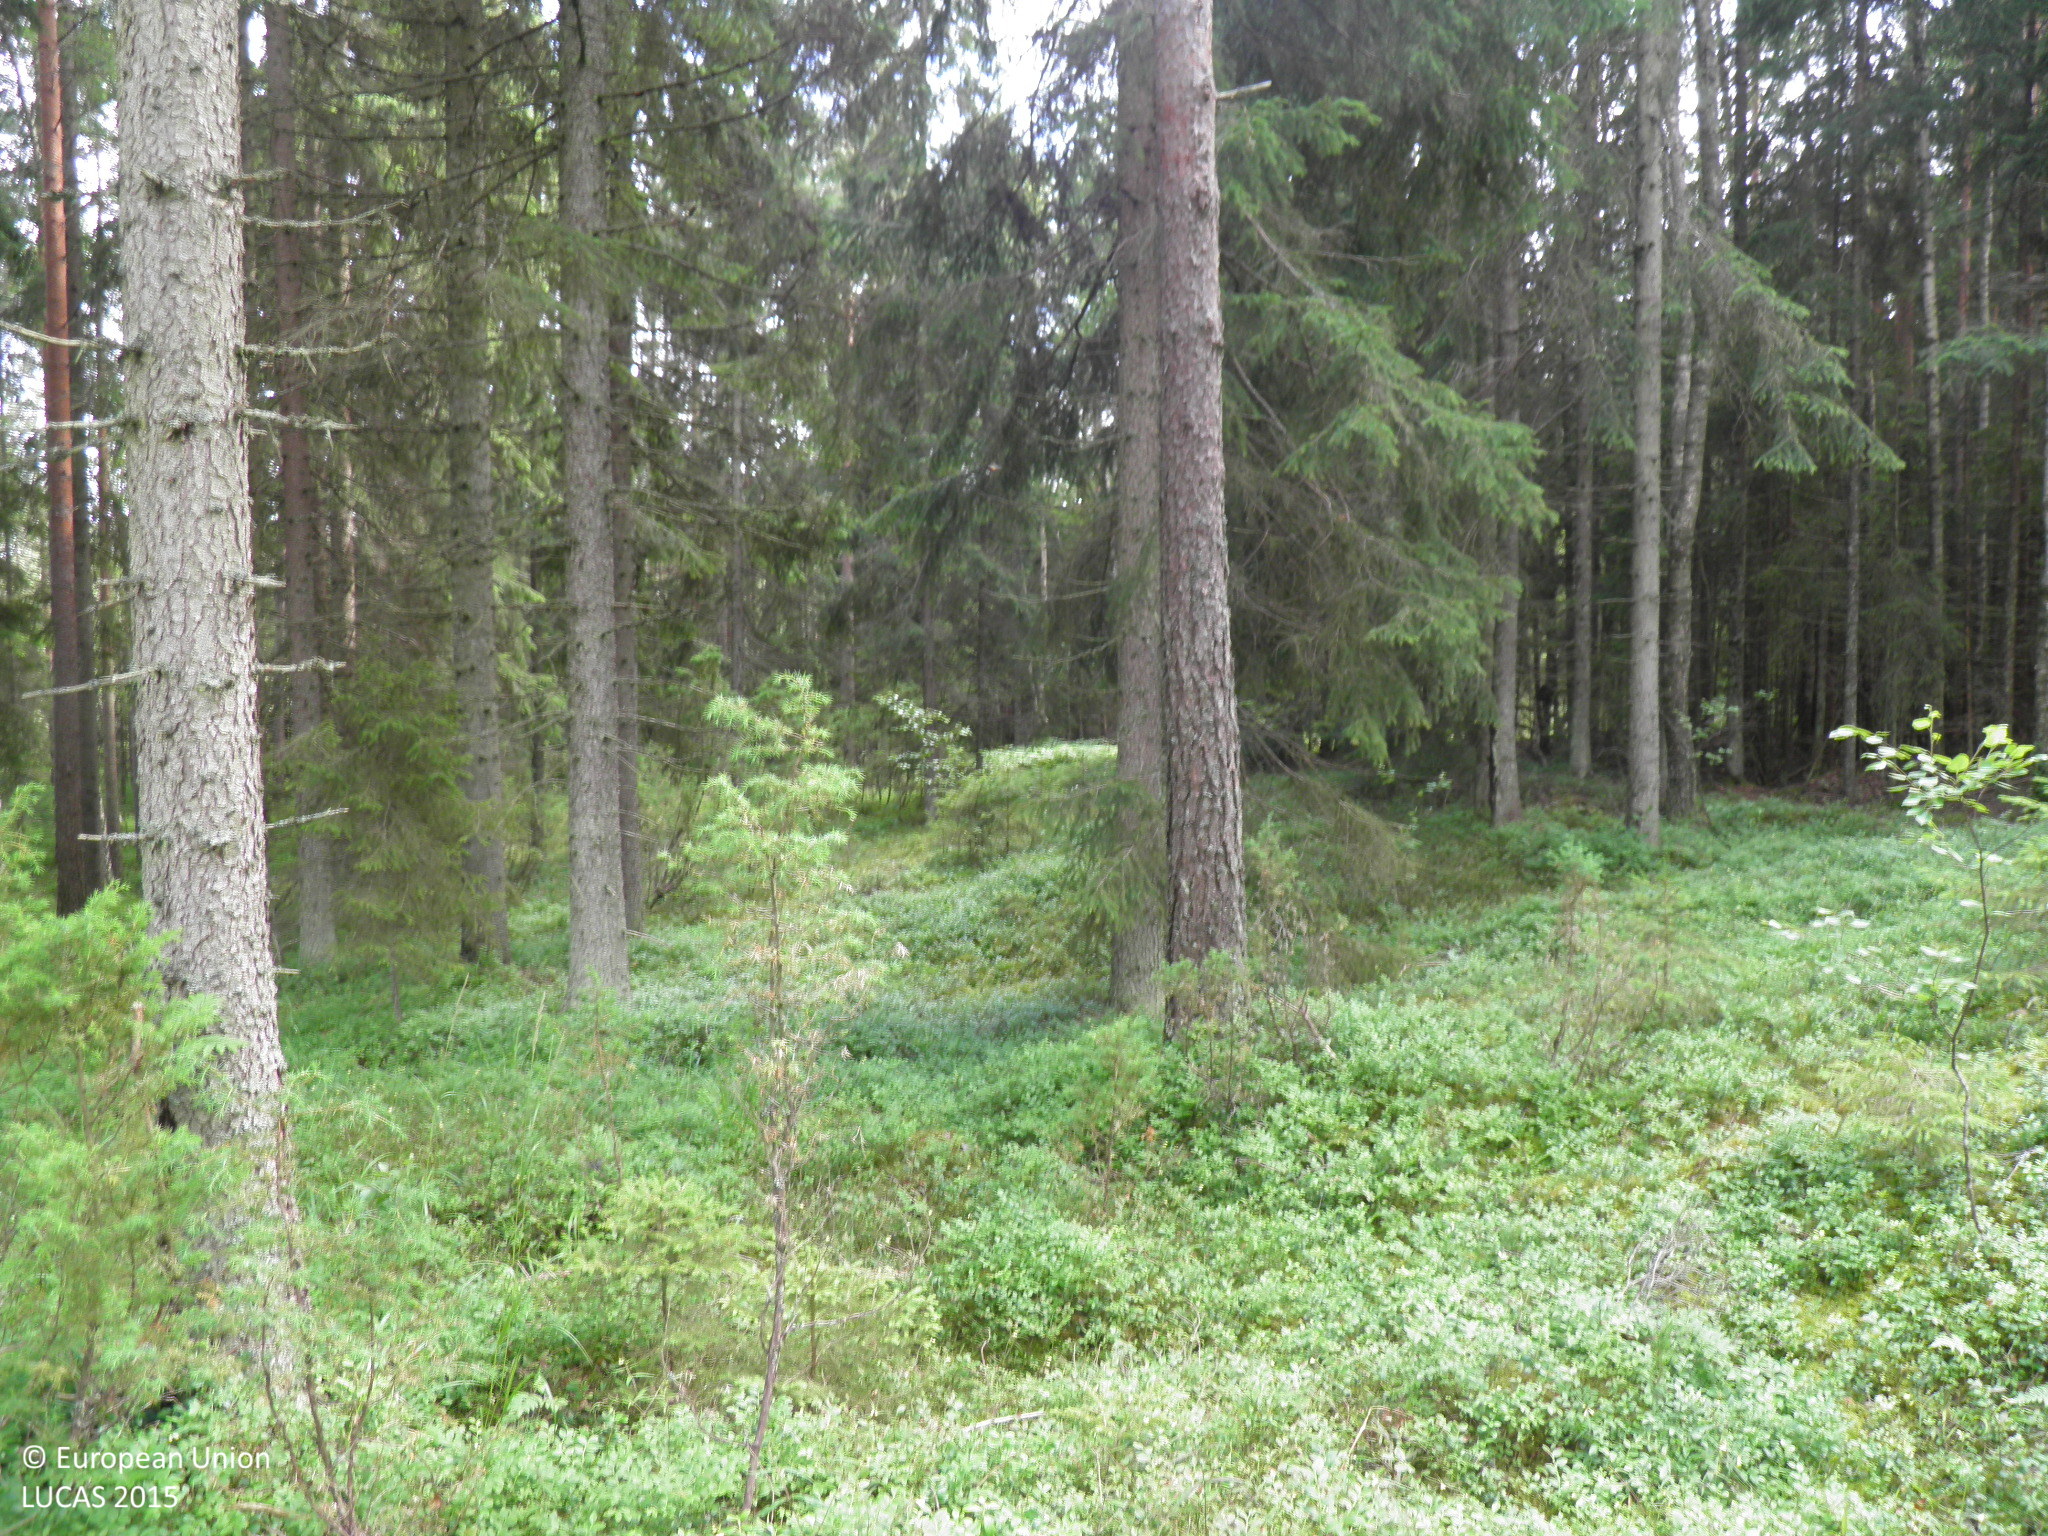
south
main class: Woodland
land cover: Spruce dominated coniferous woodland
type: boreal forest
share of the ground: 50 - 75 %
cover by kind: shrubs 50 %, coniferous forest trees 40 %, broadleaved forest trees 10 %
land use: Forestry
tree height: > 5 m
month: July
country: FI
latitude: 60.0583
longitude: 22.5208
